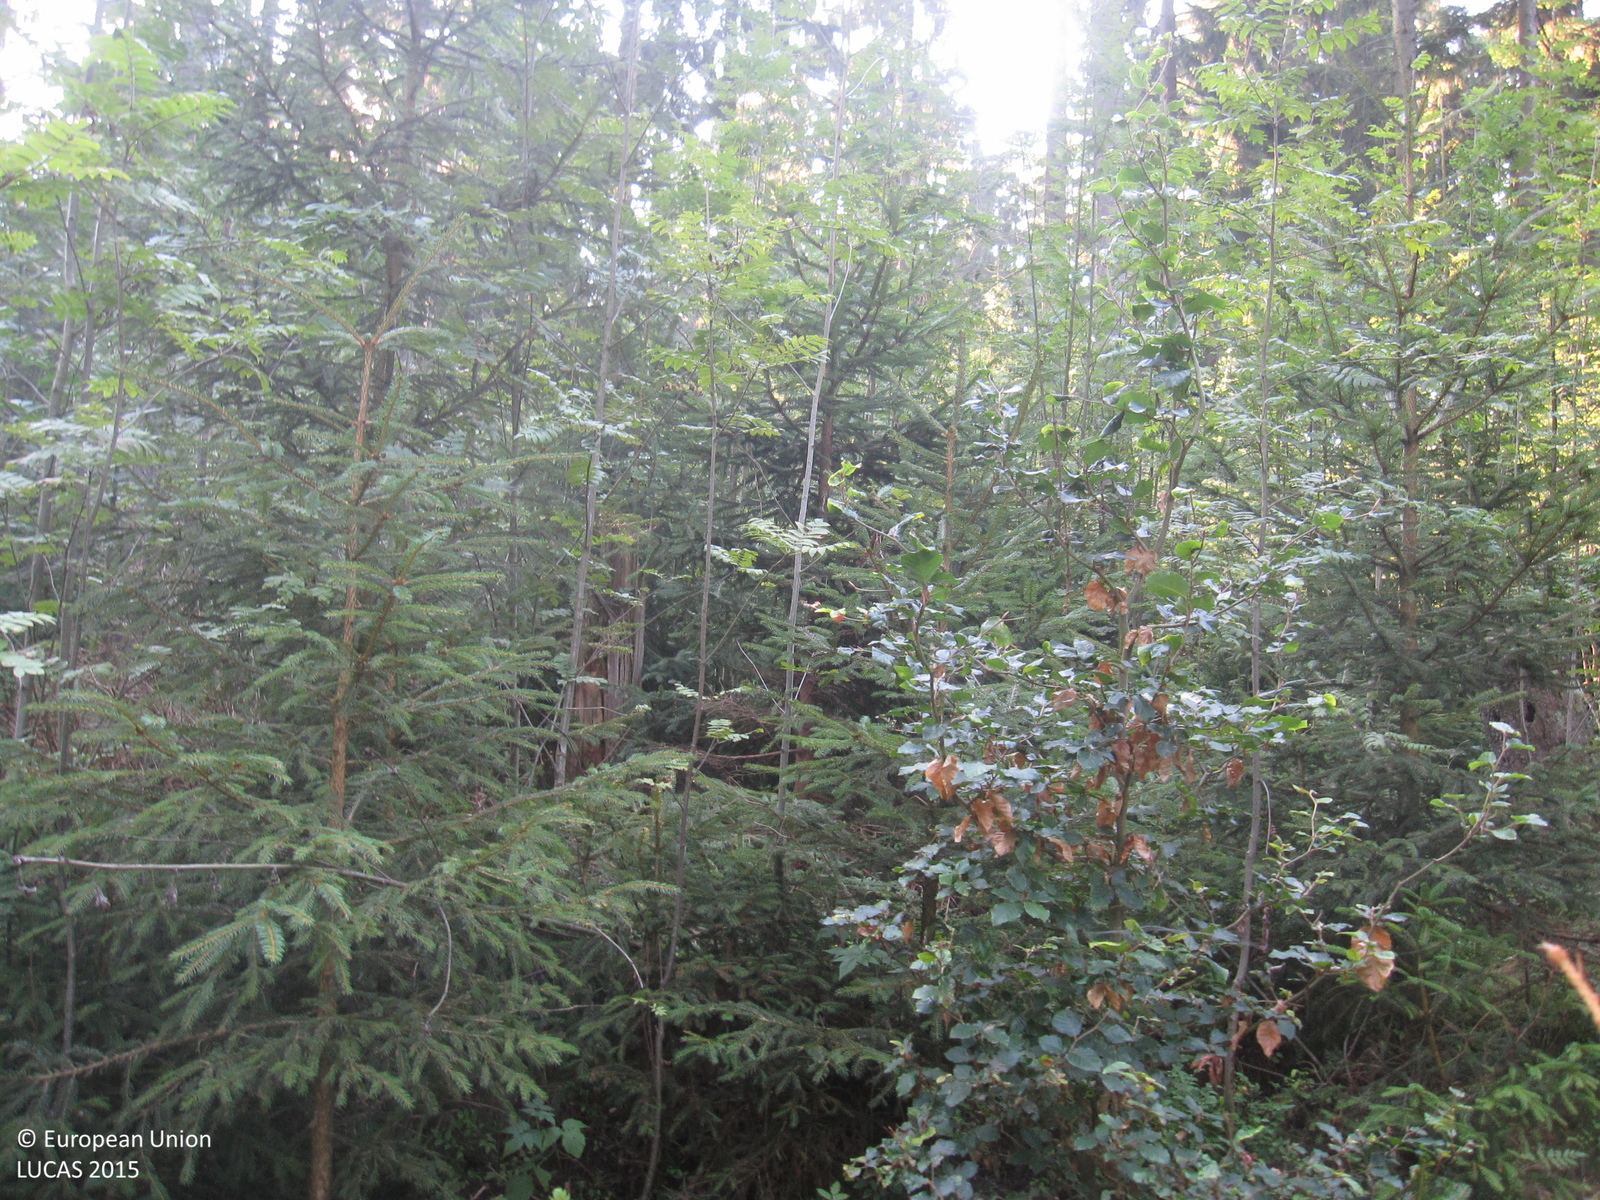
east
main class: Woodland
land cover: Spruce dominated coniferous woodland
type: hemiboreal forest and nemoral coniferous forest and mixed broadleaved-coniferous forest
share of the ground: > 75 %
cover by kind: coniferous forest trees 80 %, shrubs 10 %, herbaceous plants 10 %
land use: Forestry
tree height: > 5 m
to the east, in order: Spruce dominated coniferous woodland; Tracks; Spruce dominated coniferous woodland; Tracks; Spruce dominated coniferous woodland; Spruce dominated mixed woodland; Tracks; Spruce dominated coniferous woodland
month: August
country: DE
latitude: 50.4628
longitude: 11.4506
